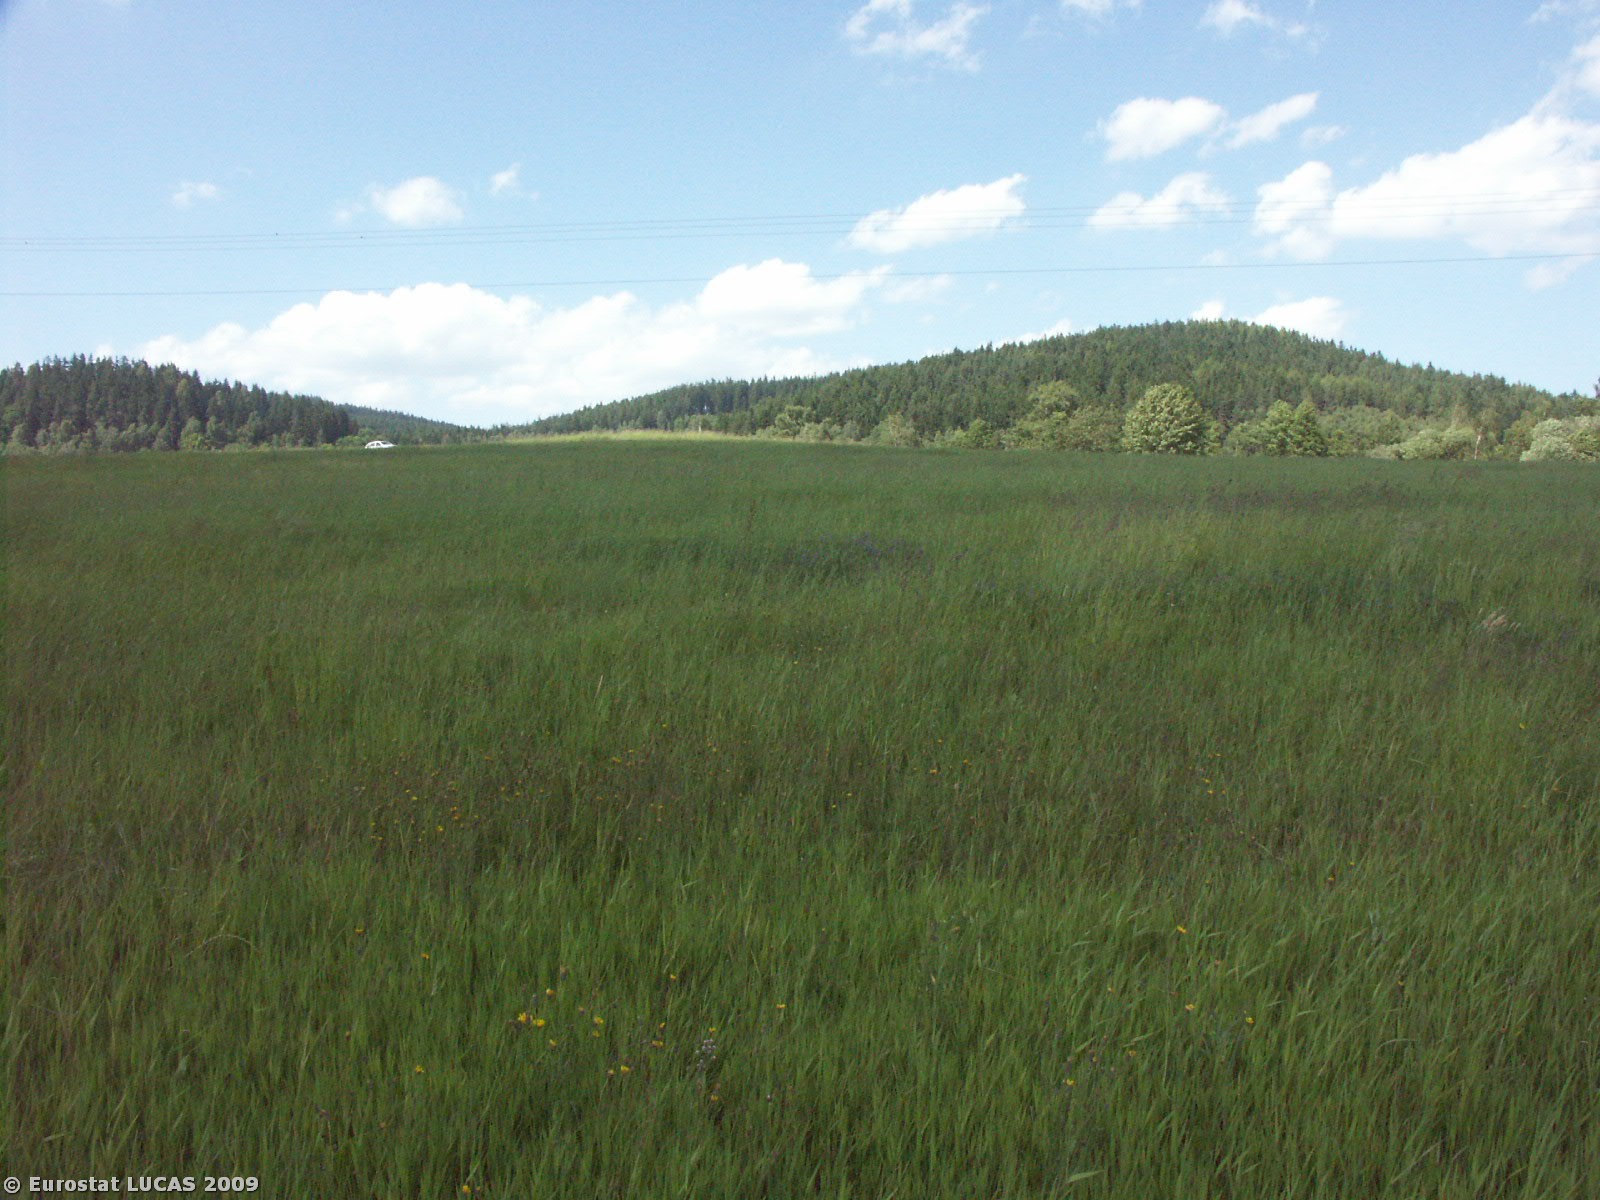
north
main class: Grassland
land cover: Grassland without tree/shrub cover
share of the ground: > 75 %
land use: Agriculture (excluding fallow land and kitchen gardens)
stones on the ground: < 10 %
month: June
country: CZ
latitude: 48.7296
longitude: 14.4192
